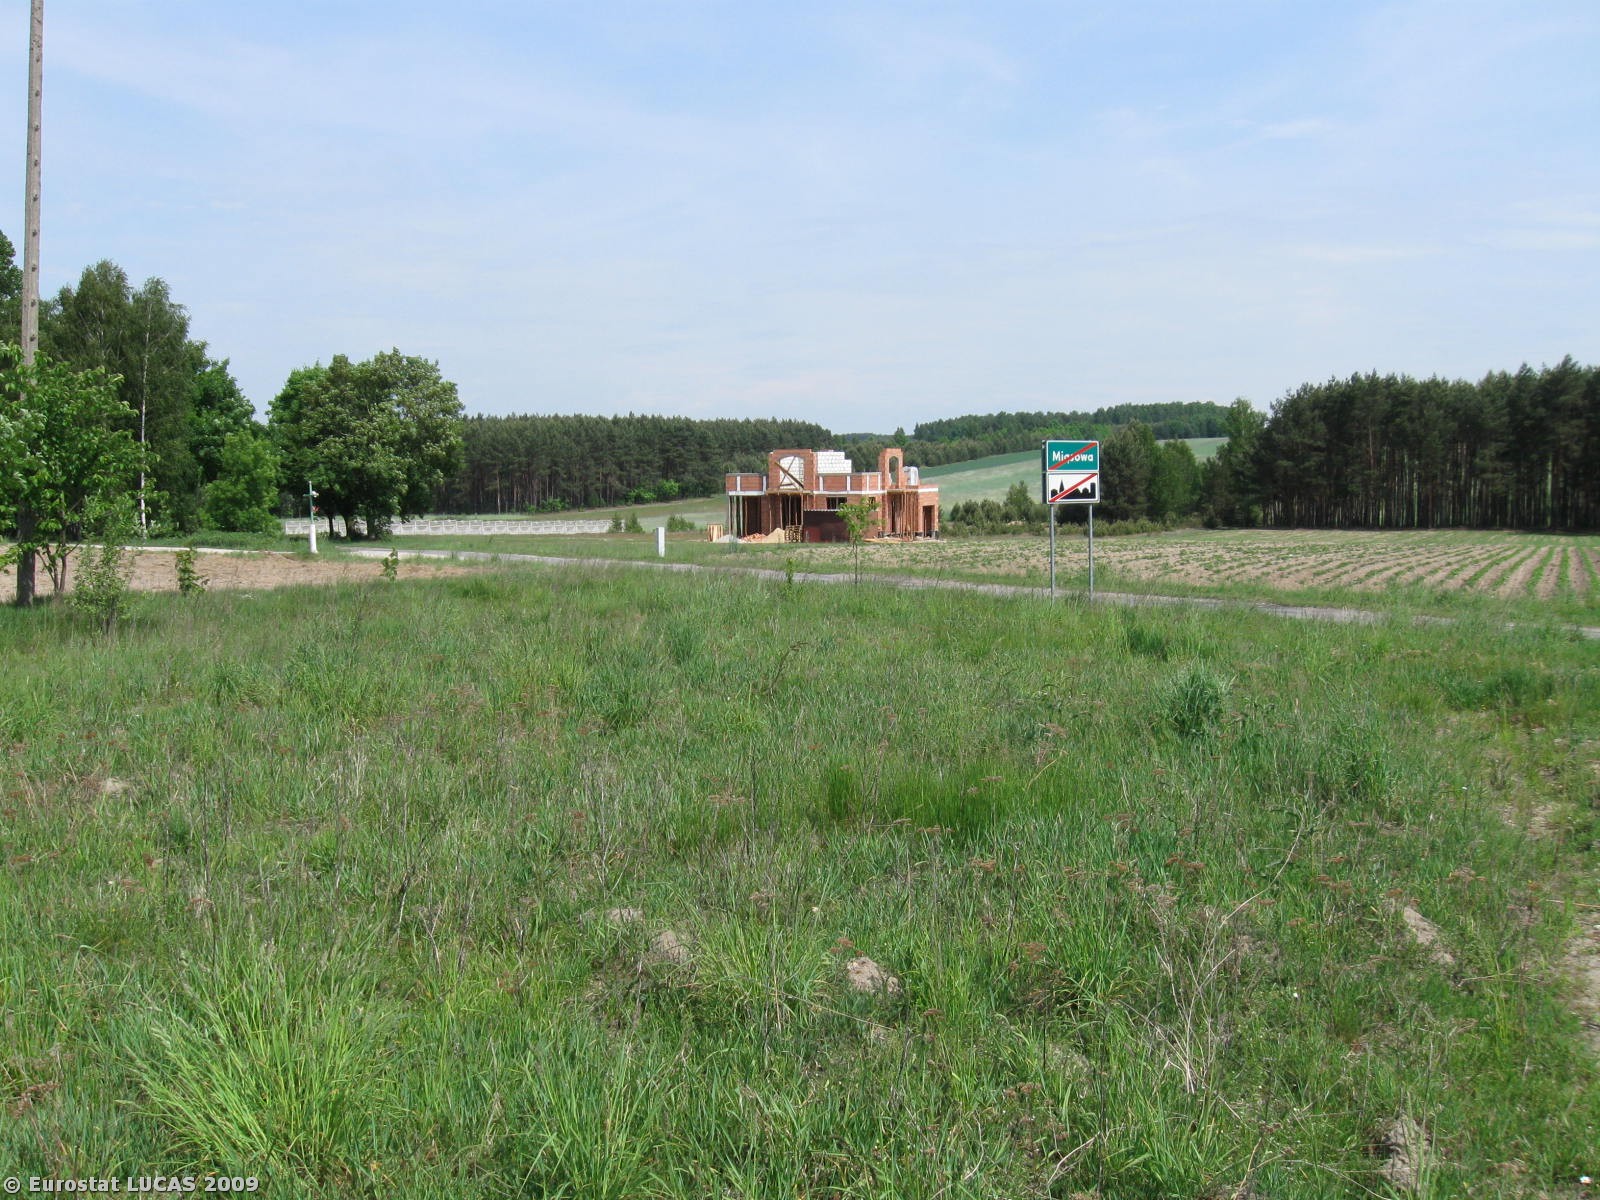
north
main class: Grassland
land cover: Grassland without tree/shrub cover
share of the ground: 50 - 75 %
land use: Unused
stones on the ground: 25 - 50 %
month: May
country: PL
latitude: 50.7260
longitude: 20.3638
